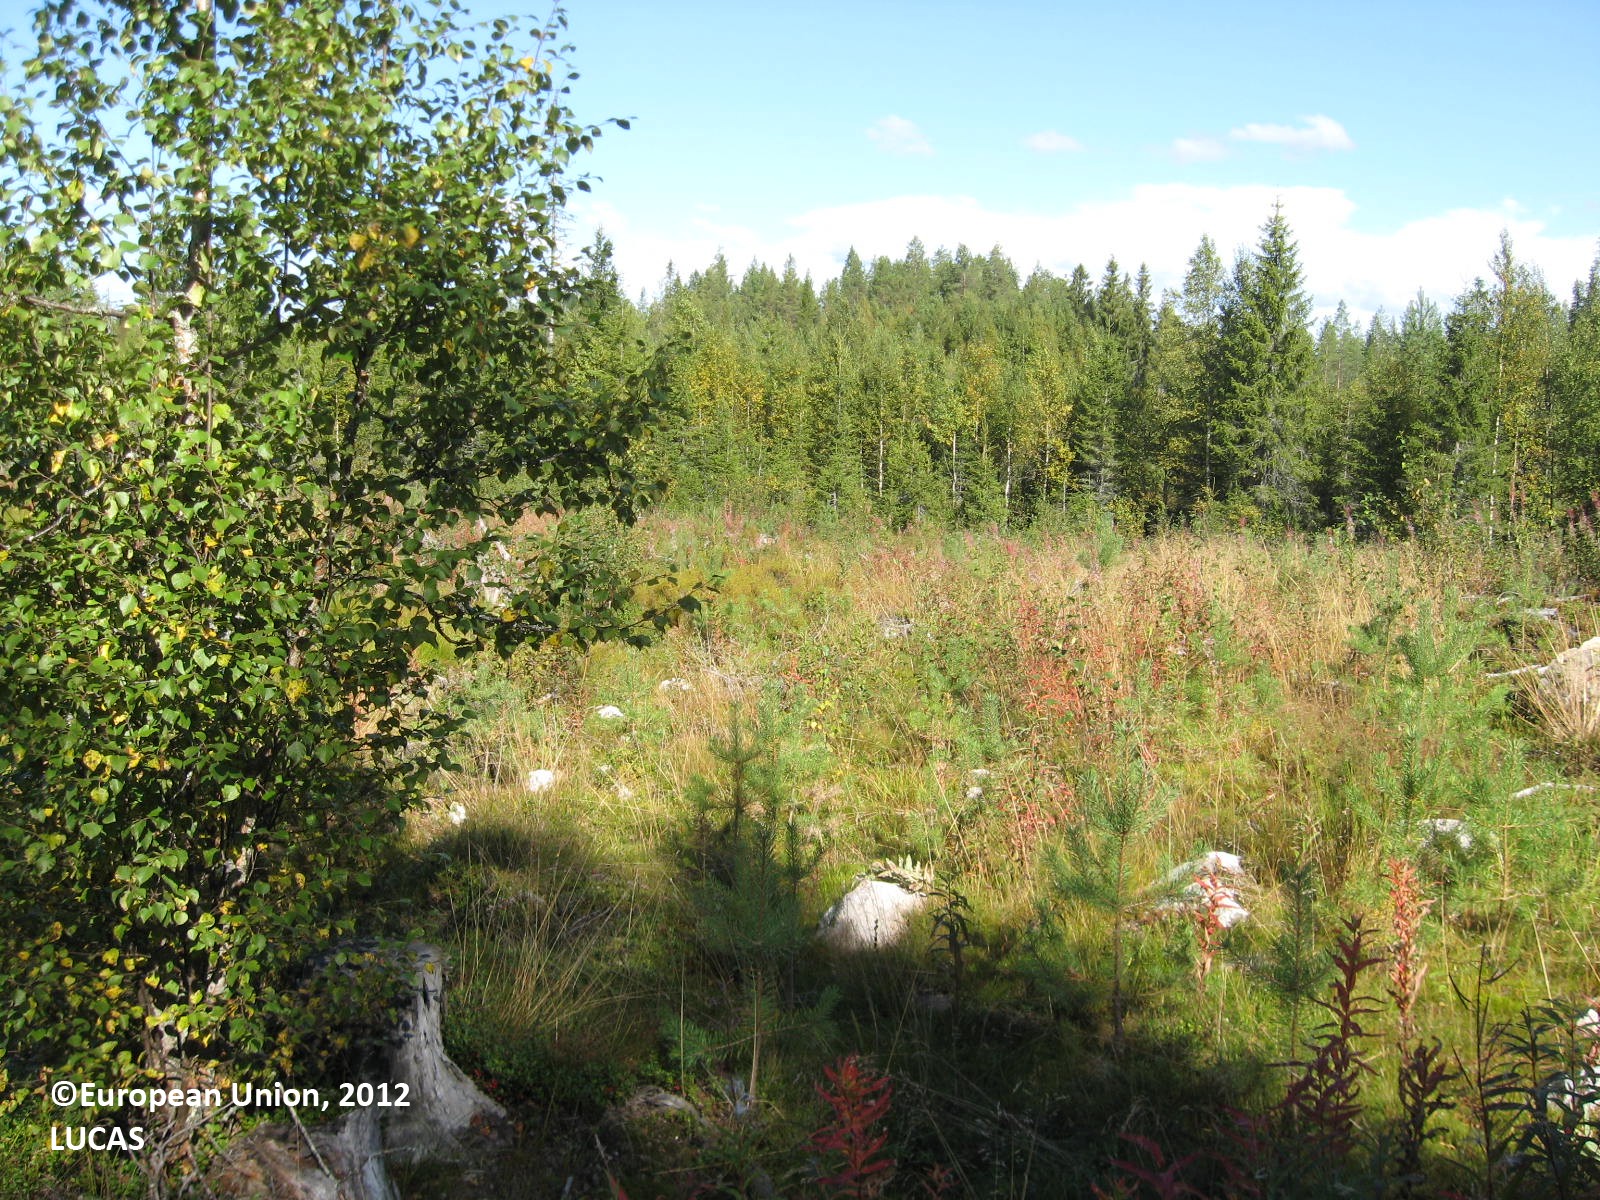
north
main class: Woodland
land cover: Other mixed woodland
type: boreal forest
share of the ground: 50 - 75 %
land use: Forestry
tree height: < 5 m
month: August
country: FI
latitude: 63.8345
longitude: 29.8514
